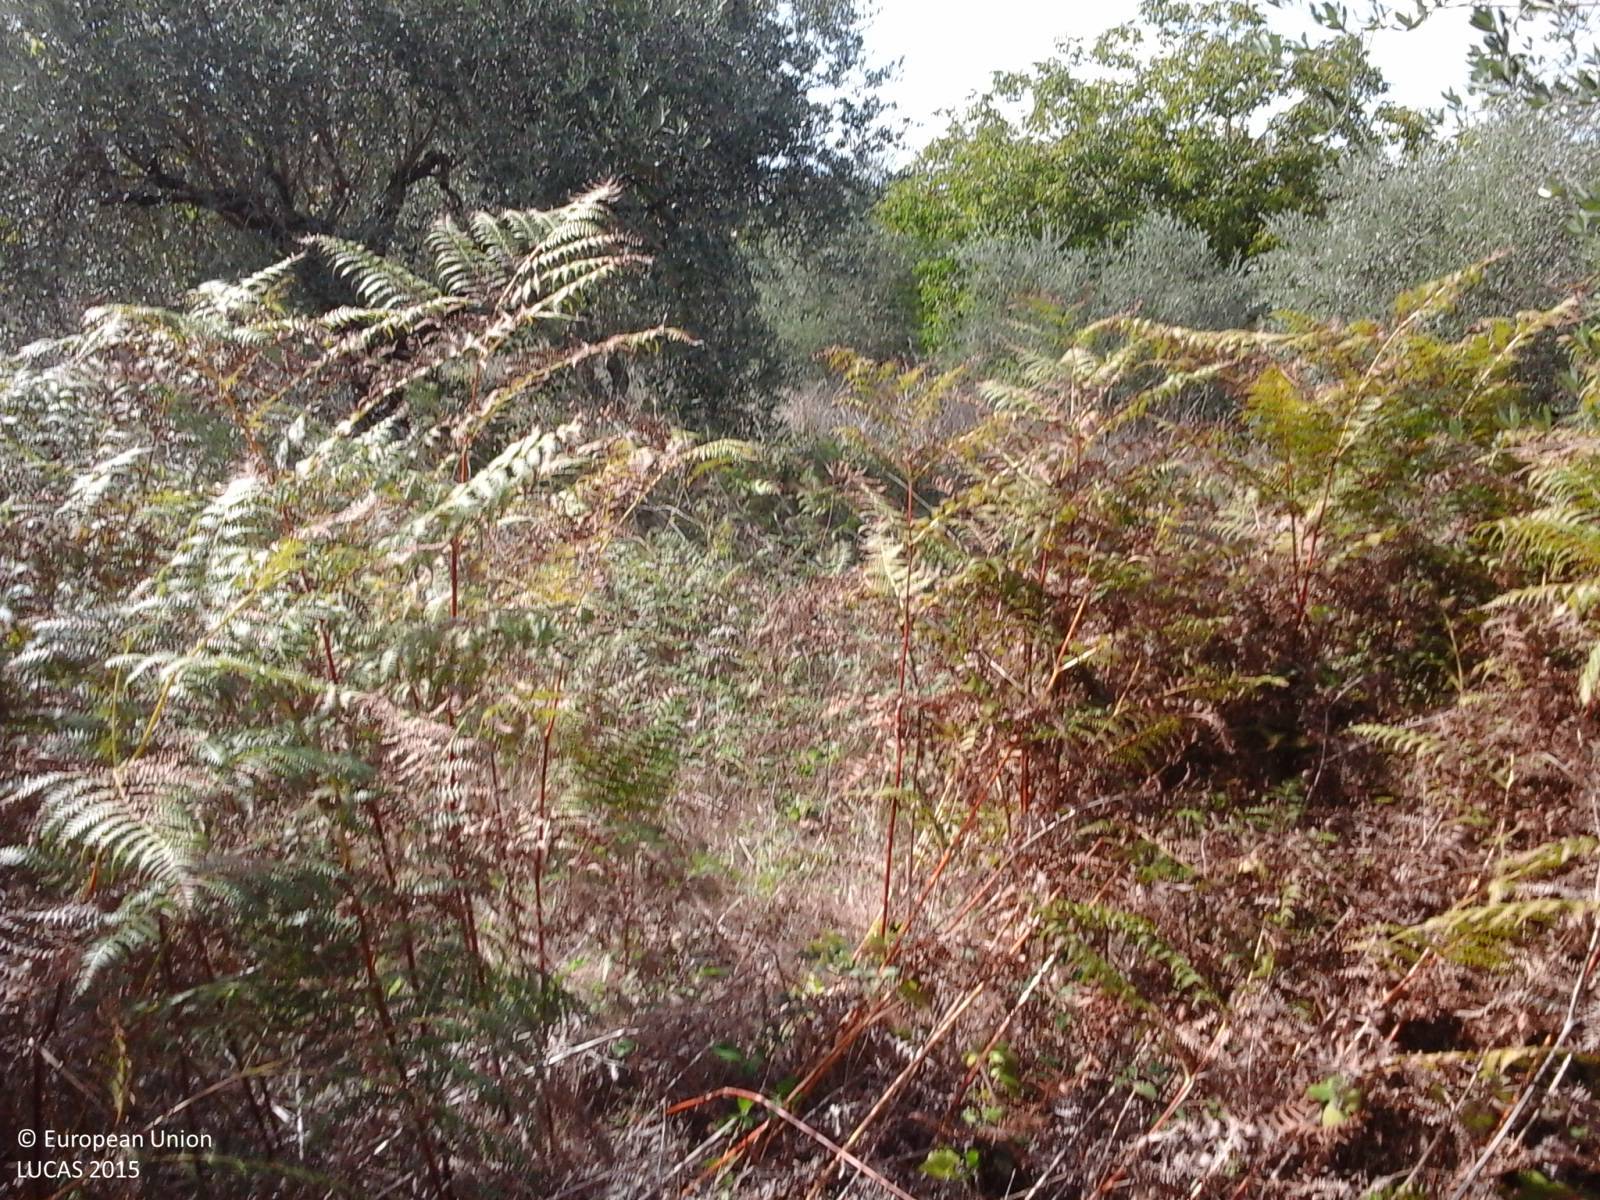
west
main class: Cropland
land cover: Olive groves
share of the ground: > 75 %
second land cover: Spontaneously vegetated surfaces
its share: > 75 %
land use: Abandoned areas
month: September
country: IT
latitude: 42.2641
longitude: 12.4041
